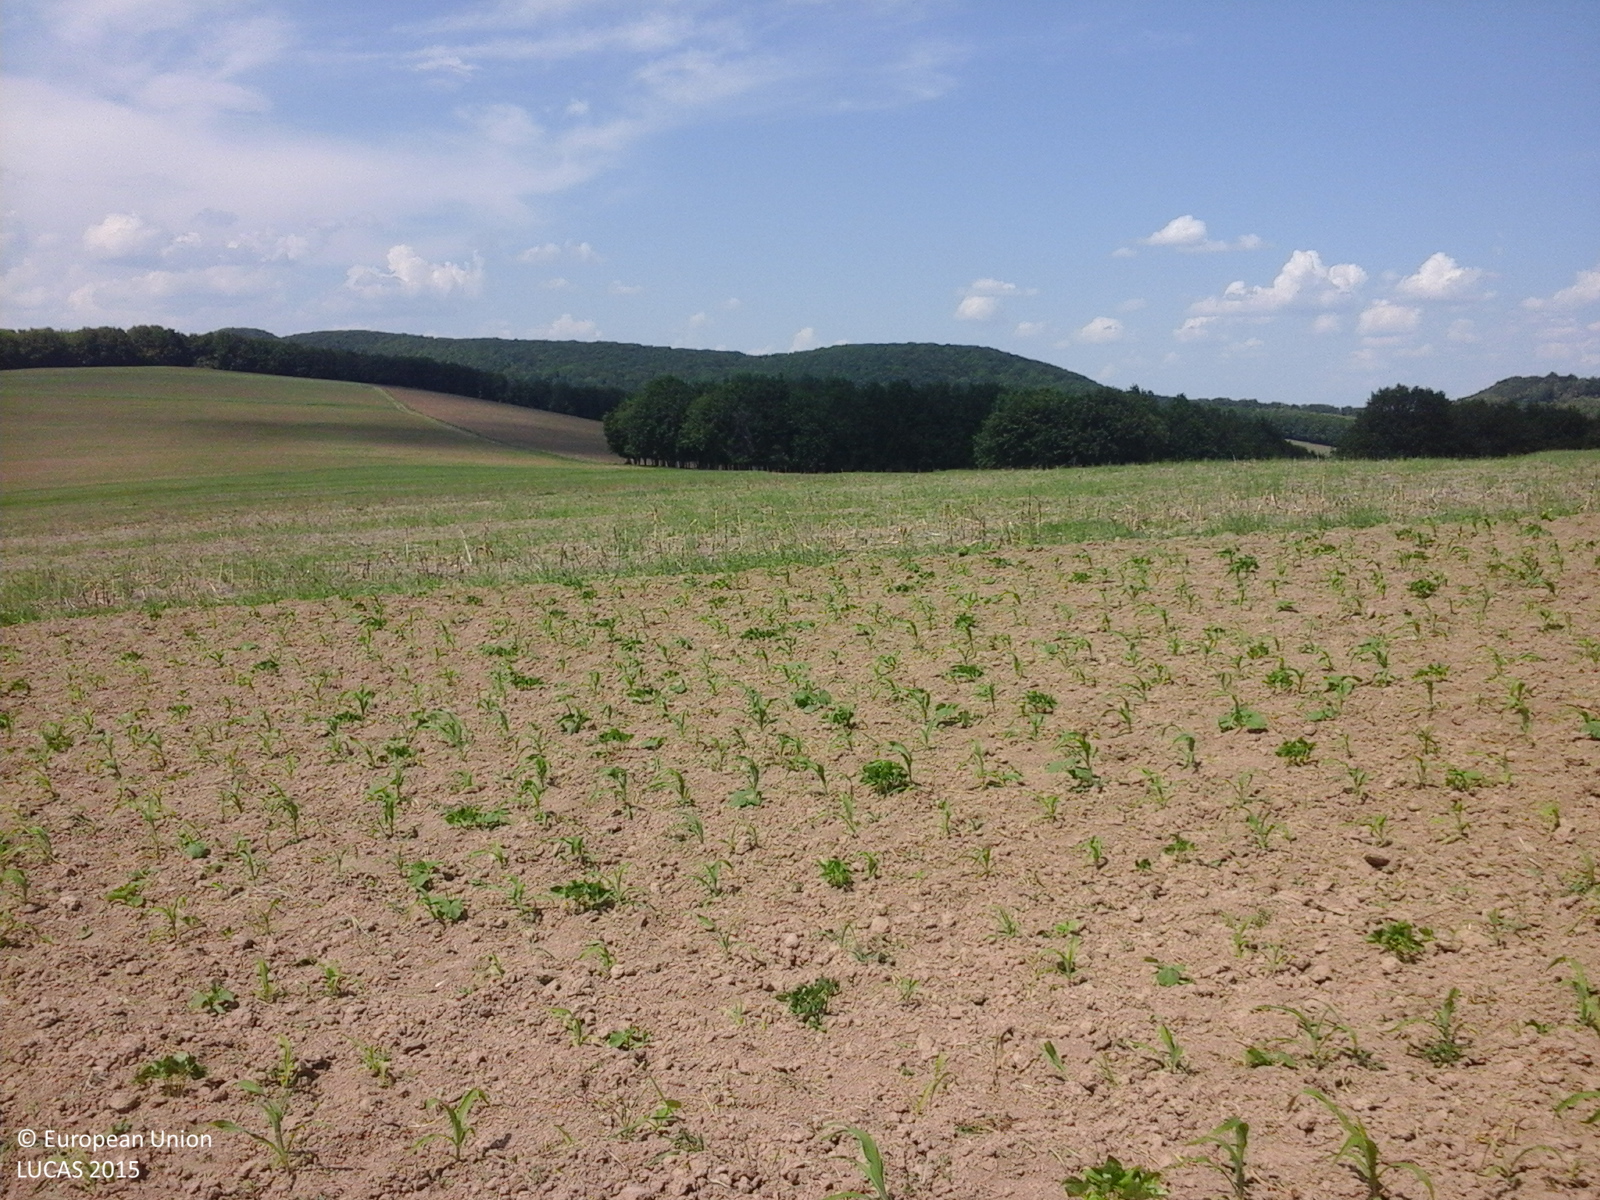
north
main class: Cropland
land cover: Maize
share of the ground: 10 - 25 %
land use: Agriculture (excluding fallow land and kitchen gardens)
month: June
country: RO
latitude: 46.3768
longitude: 26.8757
